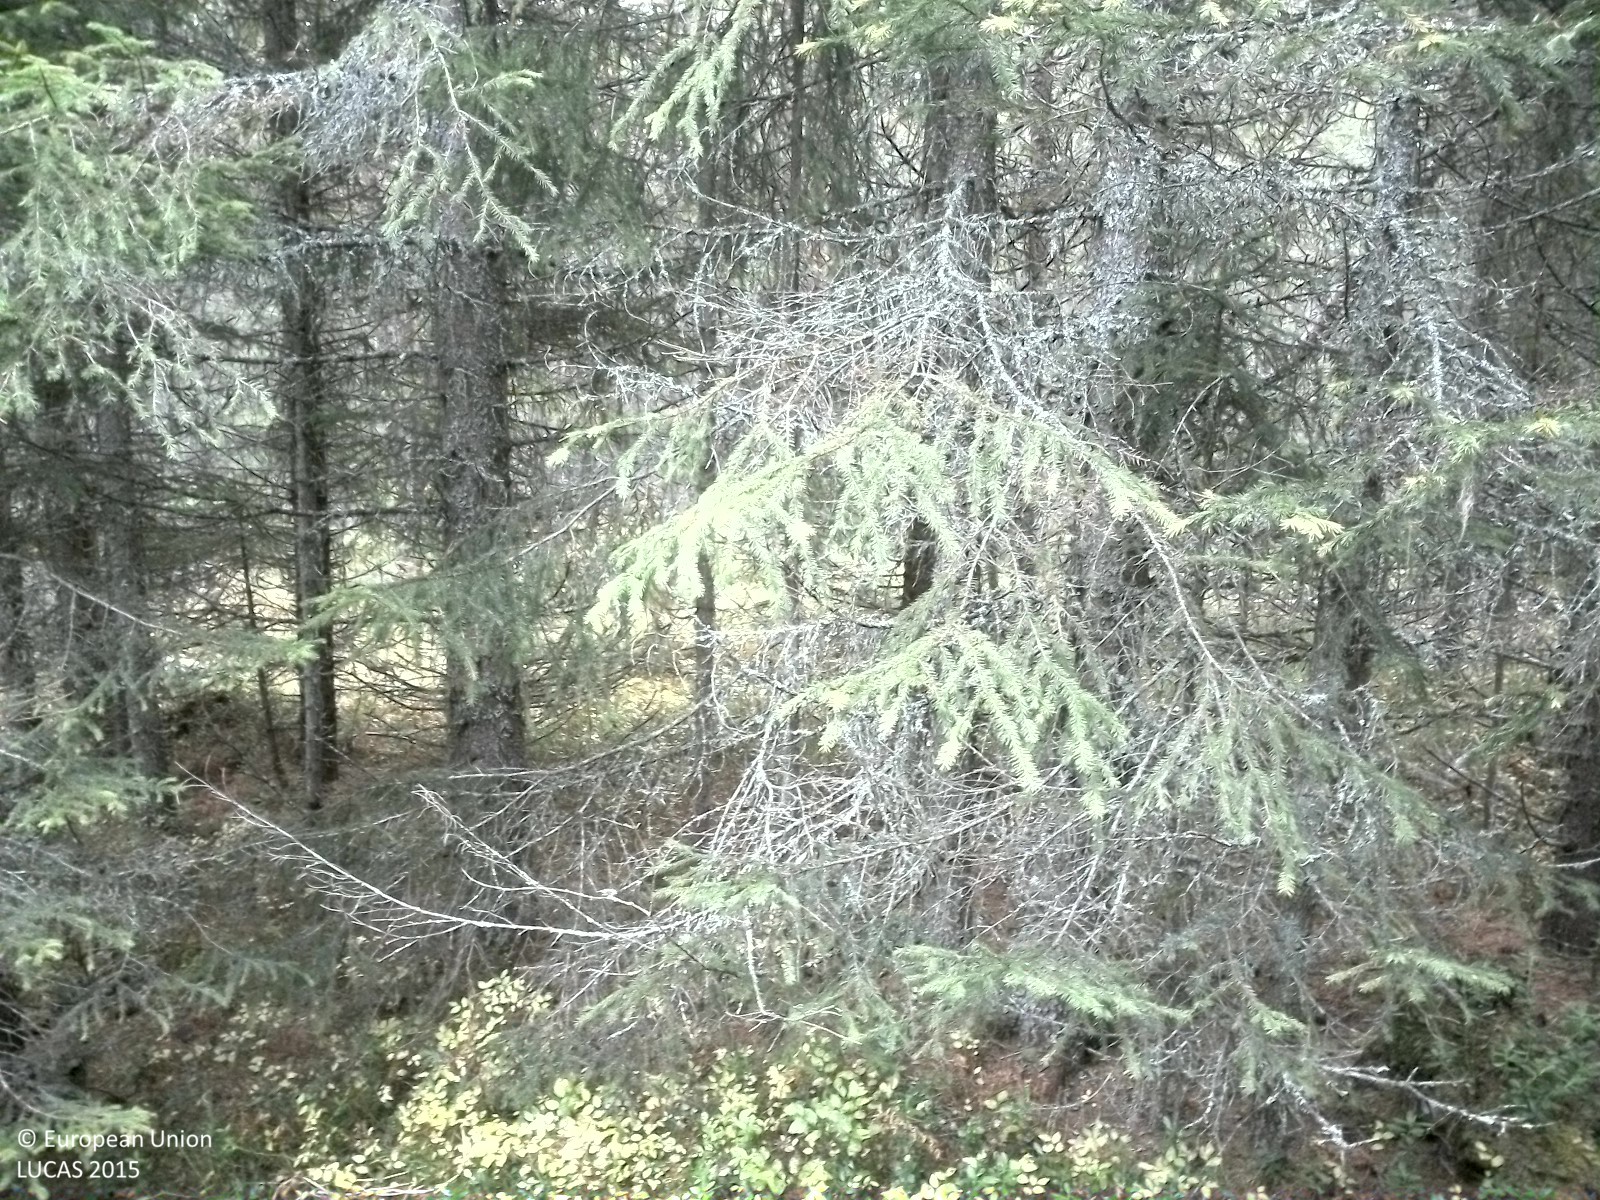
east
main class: Woodland
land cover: Spruce dominated mixed woodland
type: boreal forest
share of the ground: > 75 %
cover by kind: coniferous forest trees 60 %, broadleaved forest trees 20 %, shrubs 20 %
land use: Forestry
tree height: > 5 m
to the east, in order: Spruce dominated mixed woodland; Spruce dominated coniferous woodland; Grassland without tree/shrub cover; Spruce dominated coniferous woodland; Pine dominated coniferous woodland; Grass margins; Paved roads, cycling and walking lanes; Grass margins; Grassland with sparse tree/shrub cover
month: October
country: SE
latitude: 63.5960
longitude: 14.9946
